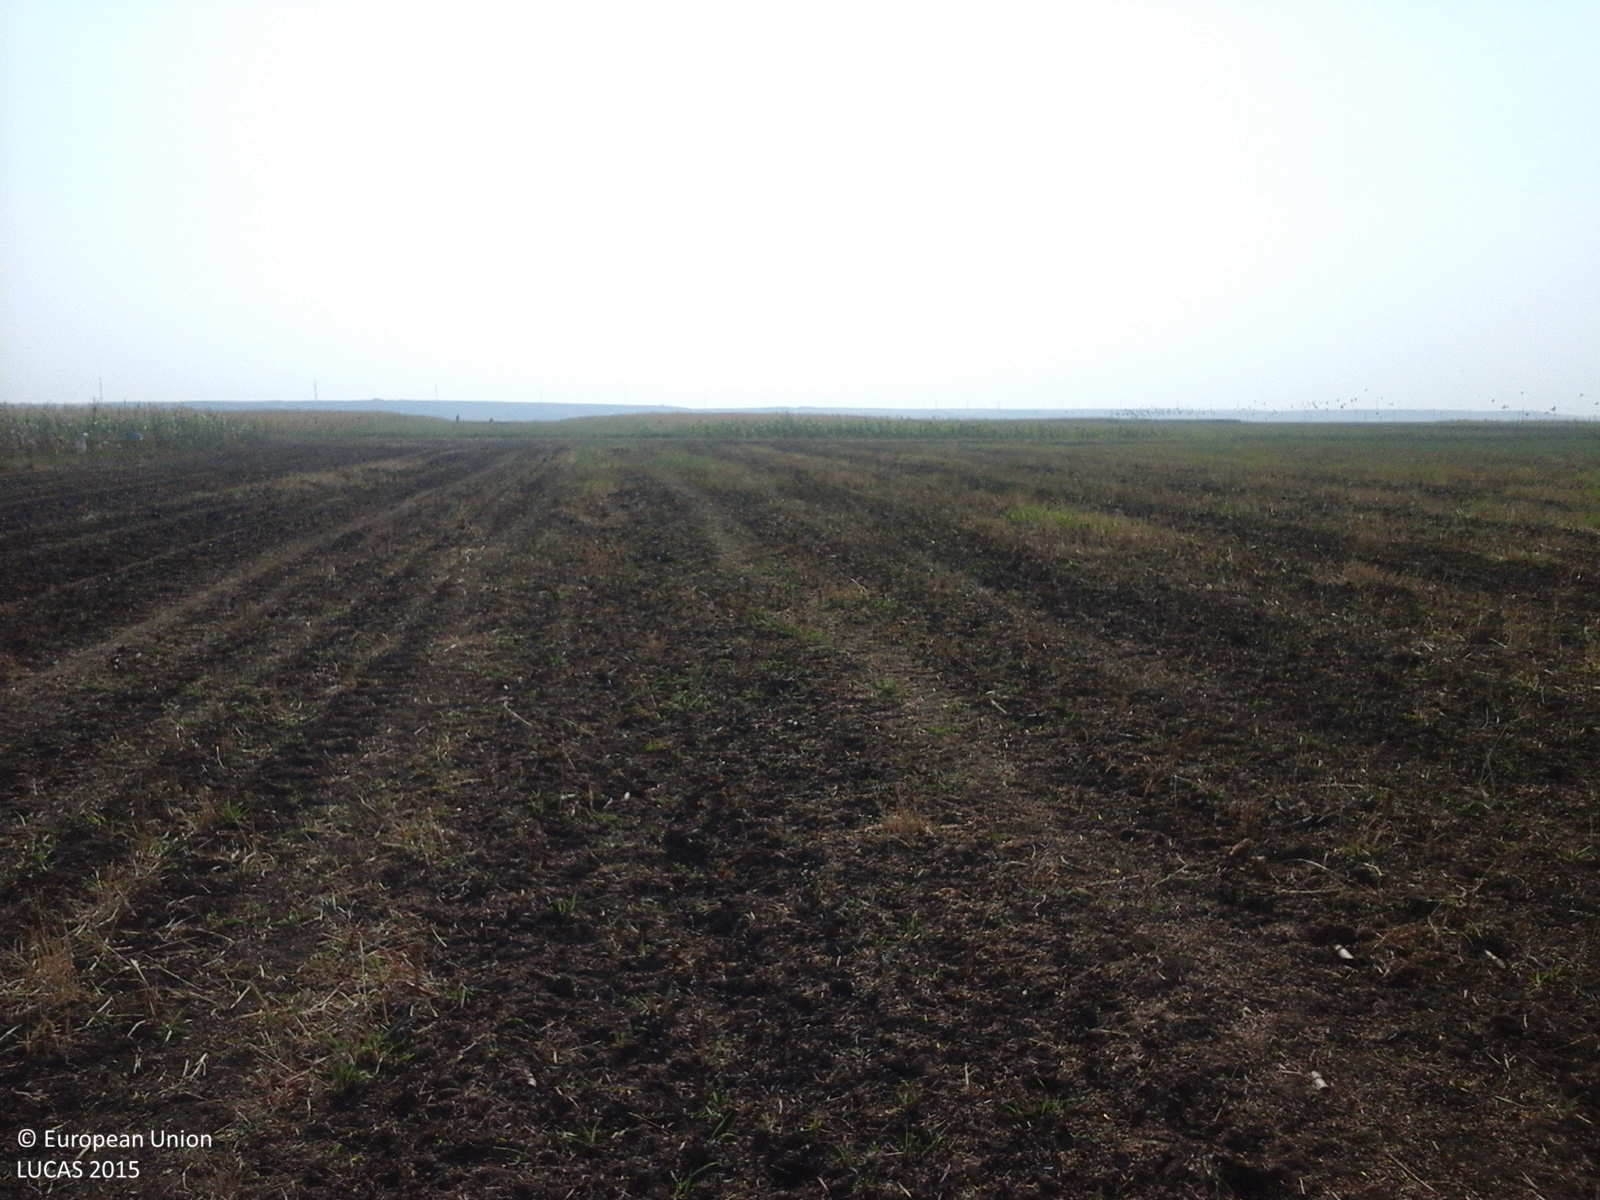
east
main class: Cropland
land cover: Common wheat
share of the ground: < 10 %
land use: Agriculture (excluding fallow land and kitchen gardens)
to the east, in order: Common wheat; Tracks; Spontaneously vegetated surfaces; Maize
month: August
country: RO
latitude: 44.1578
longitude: 22.9335
